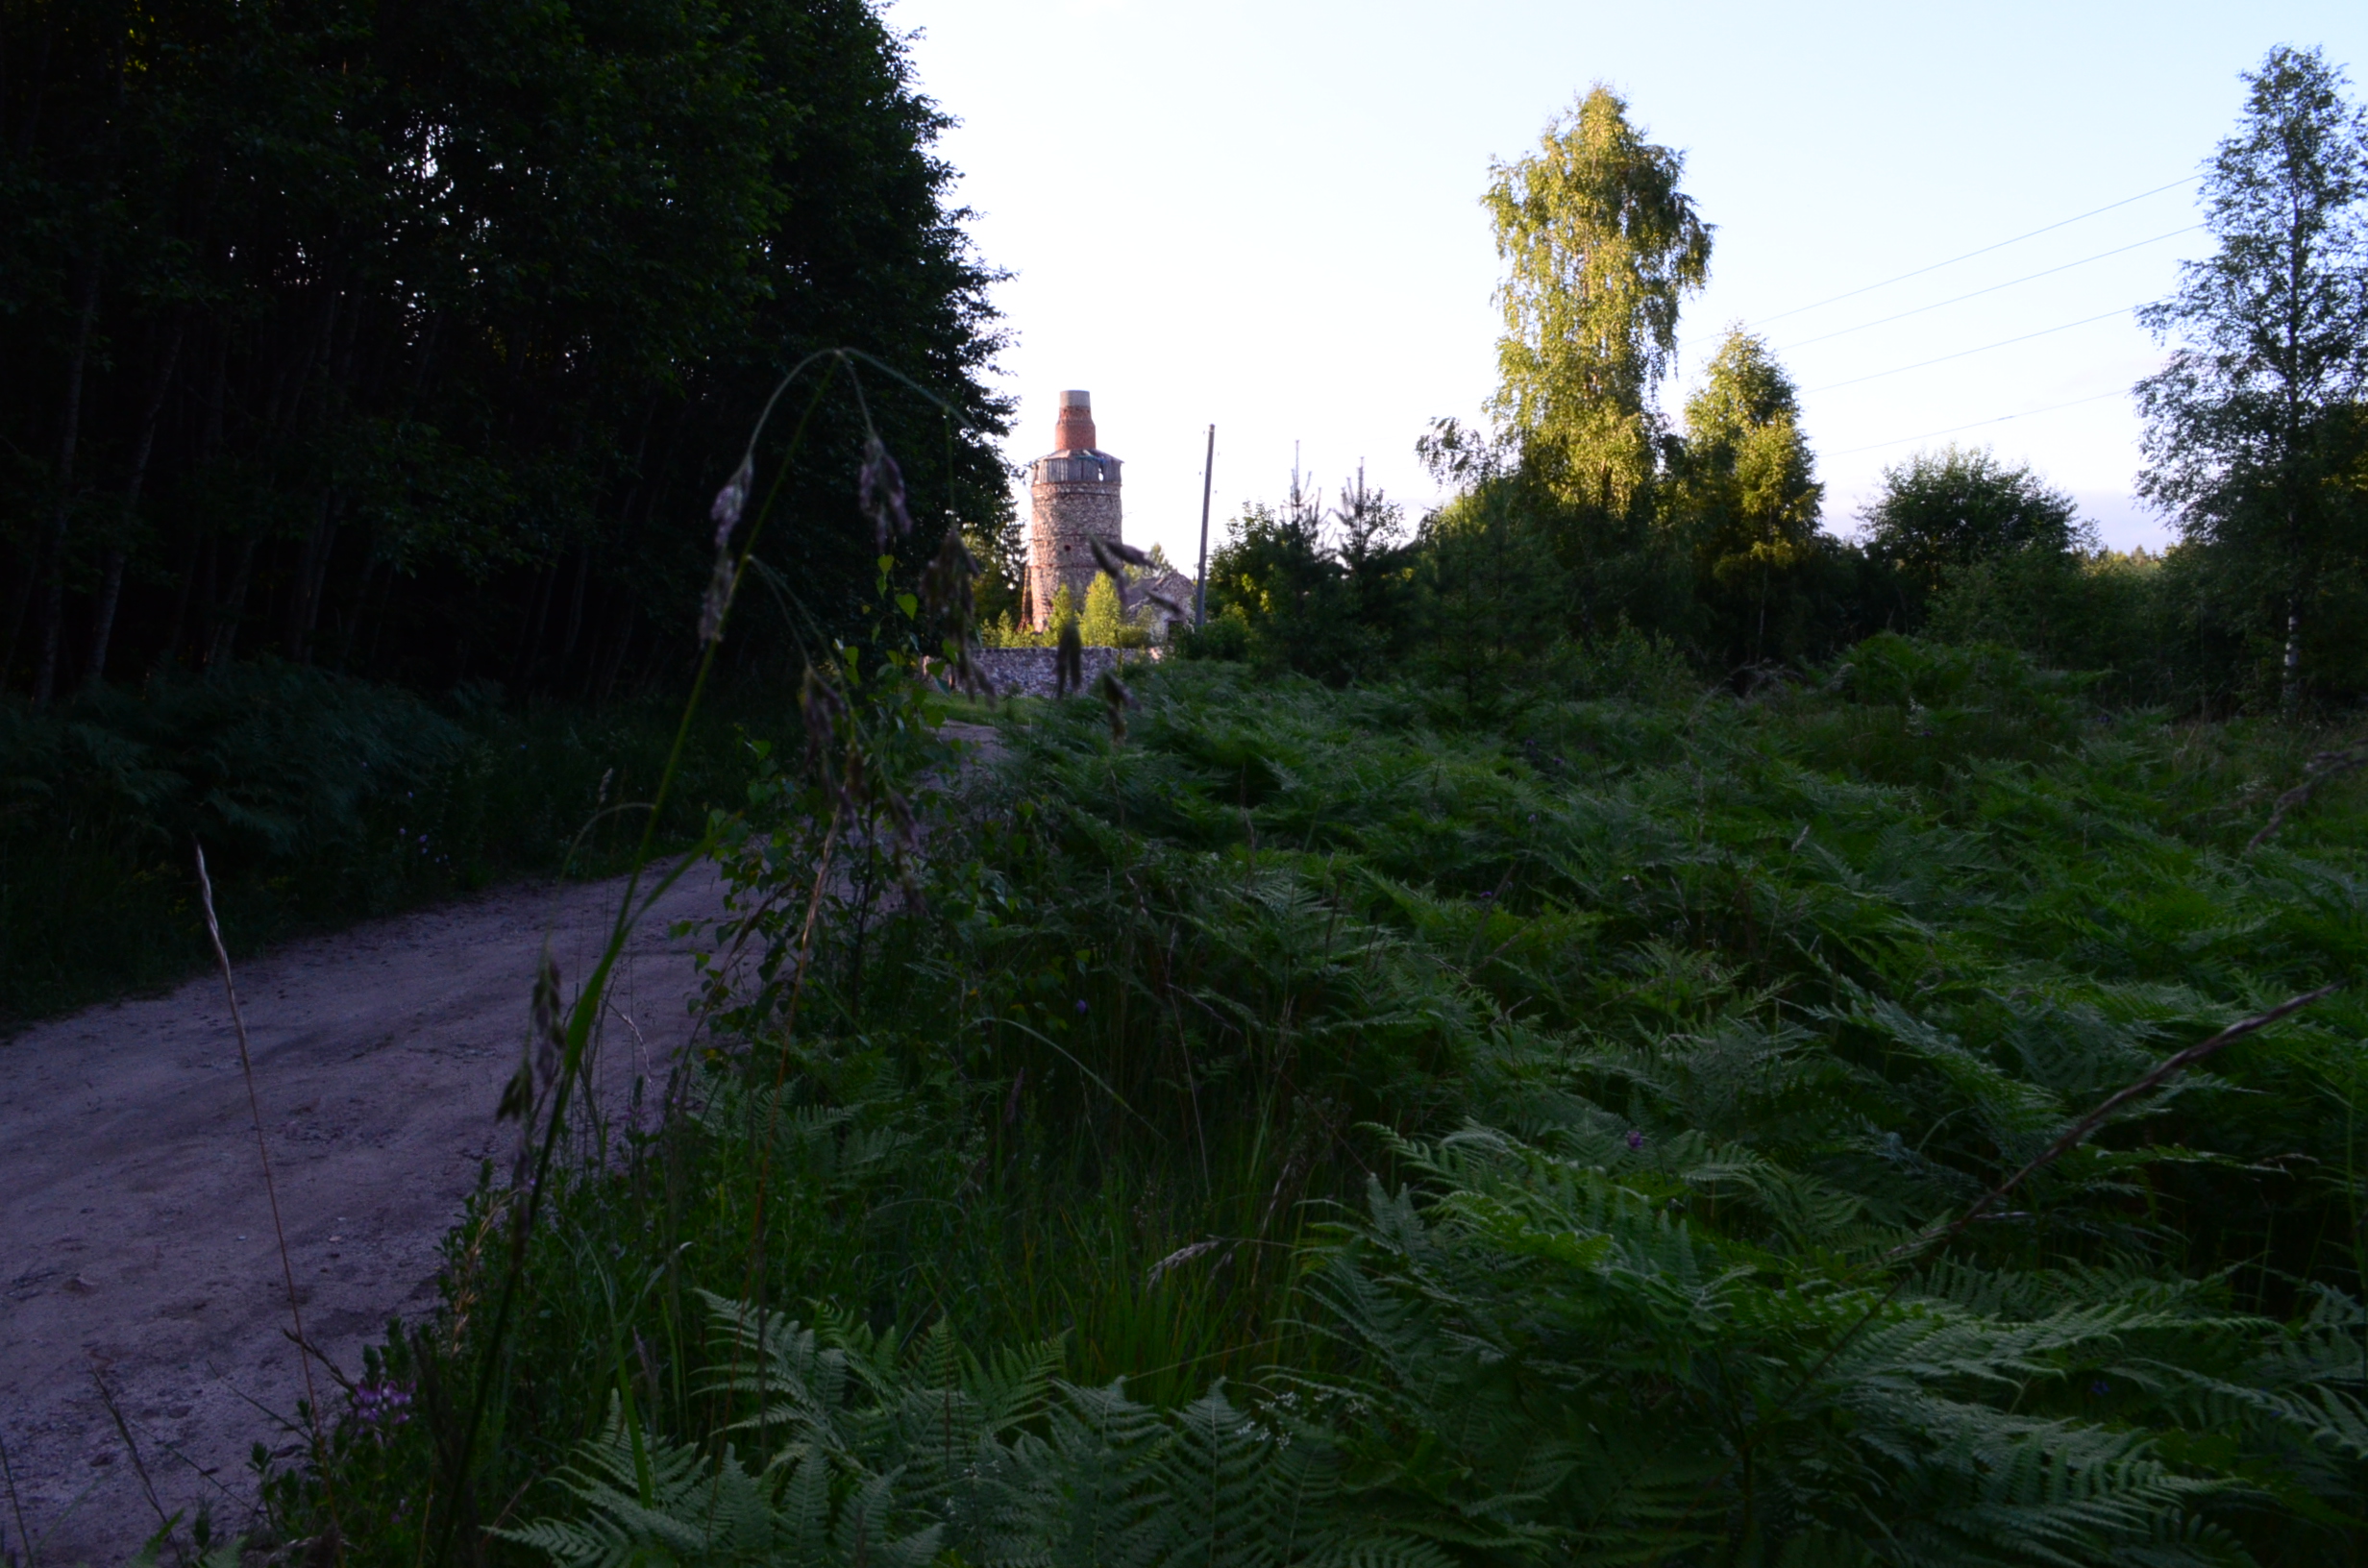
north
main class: Grassland
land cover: Grassland with sparse tree/shrub cover
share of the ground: > 75 %
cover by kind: herbaceous plants 95 %, broadleaved forest trees 5 %
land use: Semi-natural and natural areas not in use
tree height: < 5 m
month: July
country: LV
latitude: 57.0973
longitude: 22.3826
